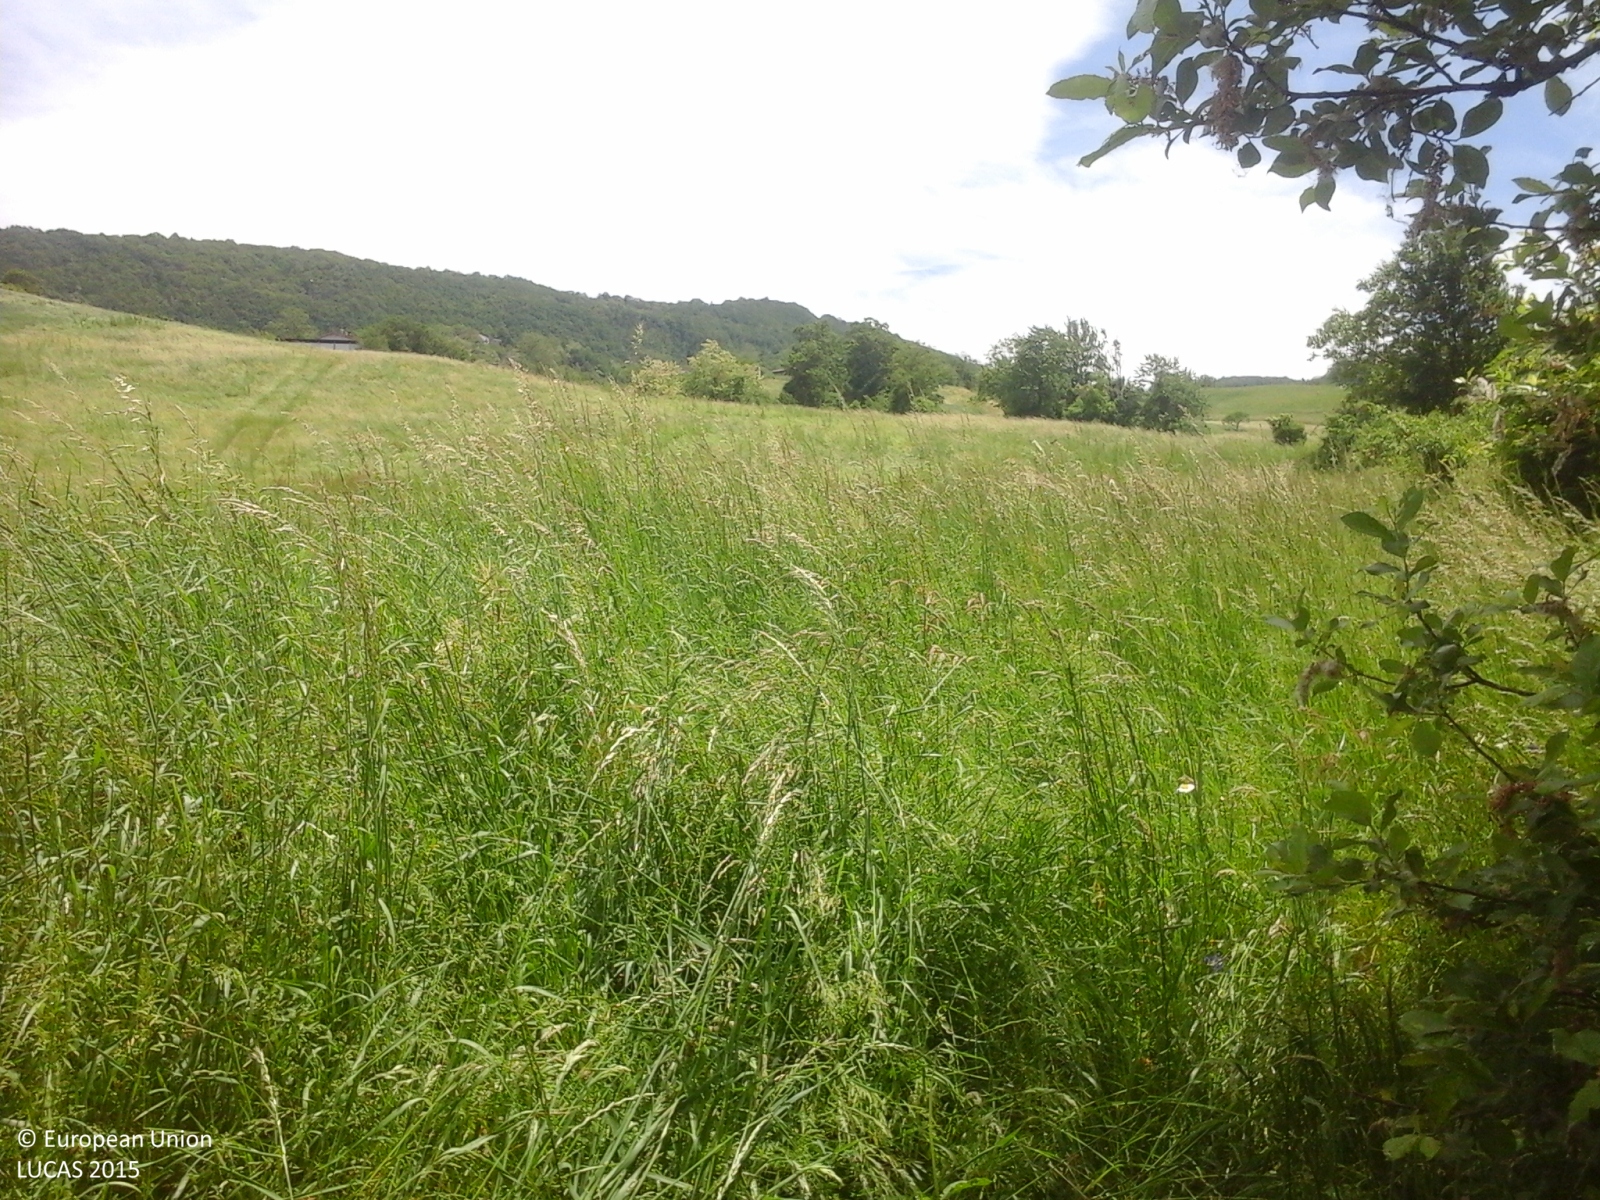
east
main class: Grassland
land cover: Spontaneously vegetated surfaces
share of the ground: > 75 %
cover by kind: herbaceous plants 100 %
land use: Agriculture (excluding fallow land and kitchen gardens)
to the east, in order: Spontaneously vegetated surfaces; Grassland without tree/shrub cover; Tracks; Grassland without tree/shrub cover; Tracks; Grassland without tree/shrub cover; Paved roads, cycling and walking lanes; Grassland without tree/shrub cover; Single bushes/trees
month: May
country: IT
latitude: 44.2383
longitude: 10.9119
